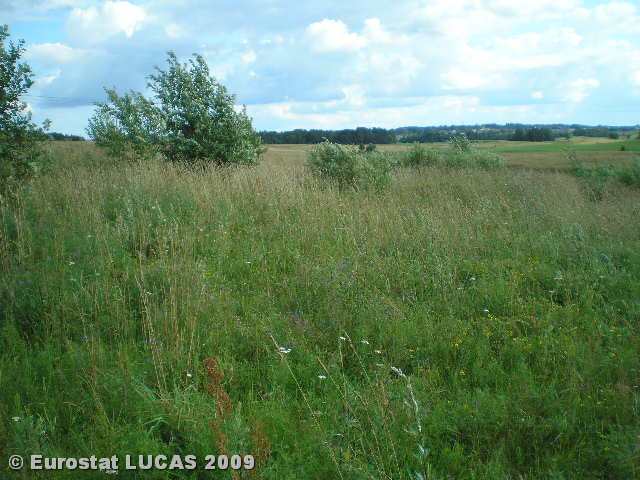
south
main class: Grassland
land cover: Spontaneously vegetated surfaces
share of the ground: > 75 %
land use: Fallow land
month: July
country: LT
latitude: 55.0189
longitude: 25.3399
